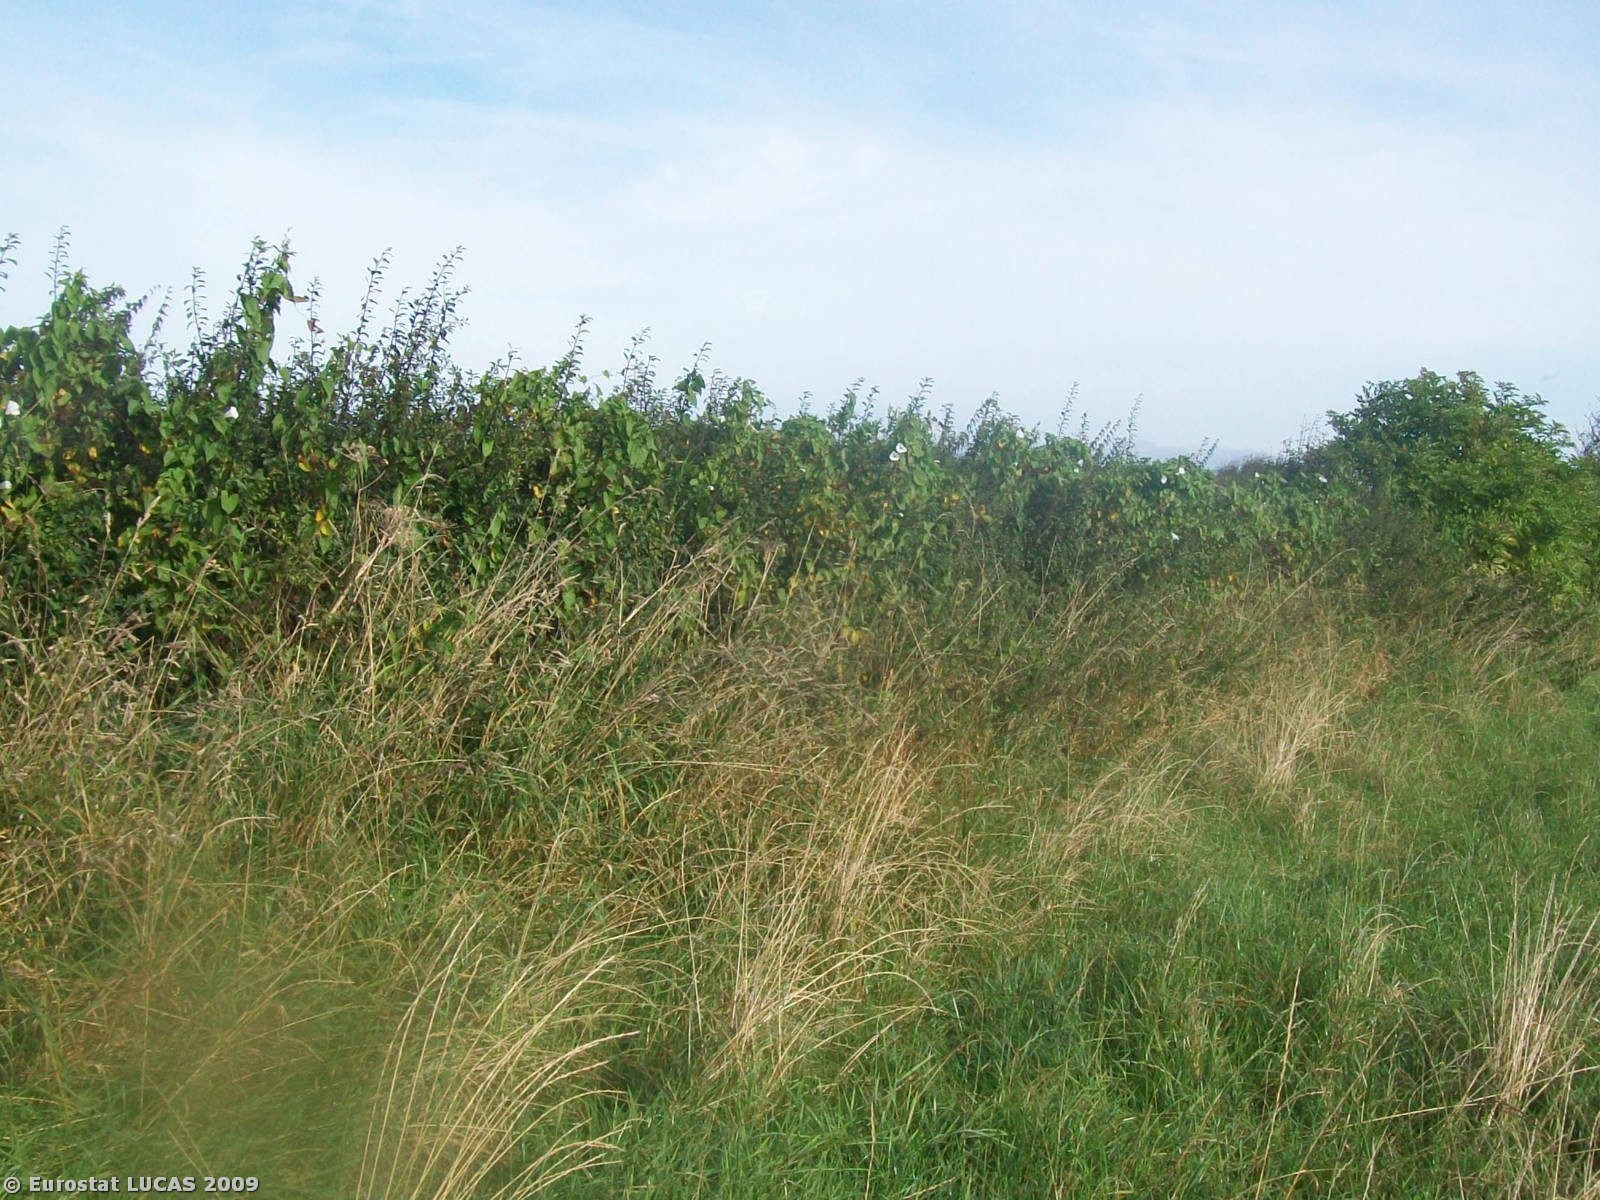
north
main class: Grassland
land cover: Grassland without tree/shrub cover
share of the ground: > 75 %
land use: Agriculture (excluding fallow land and kitchen gardens)
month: September
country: GB
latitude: 51.4334
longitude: -3.5346
